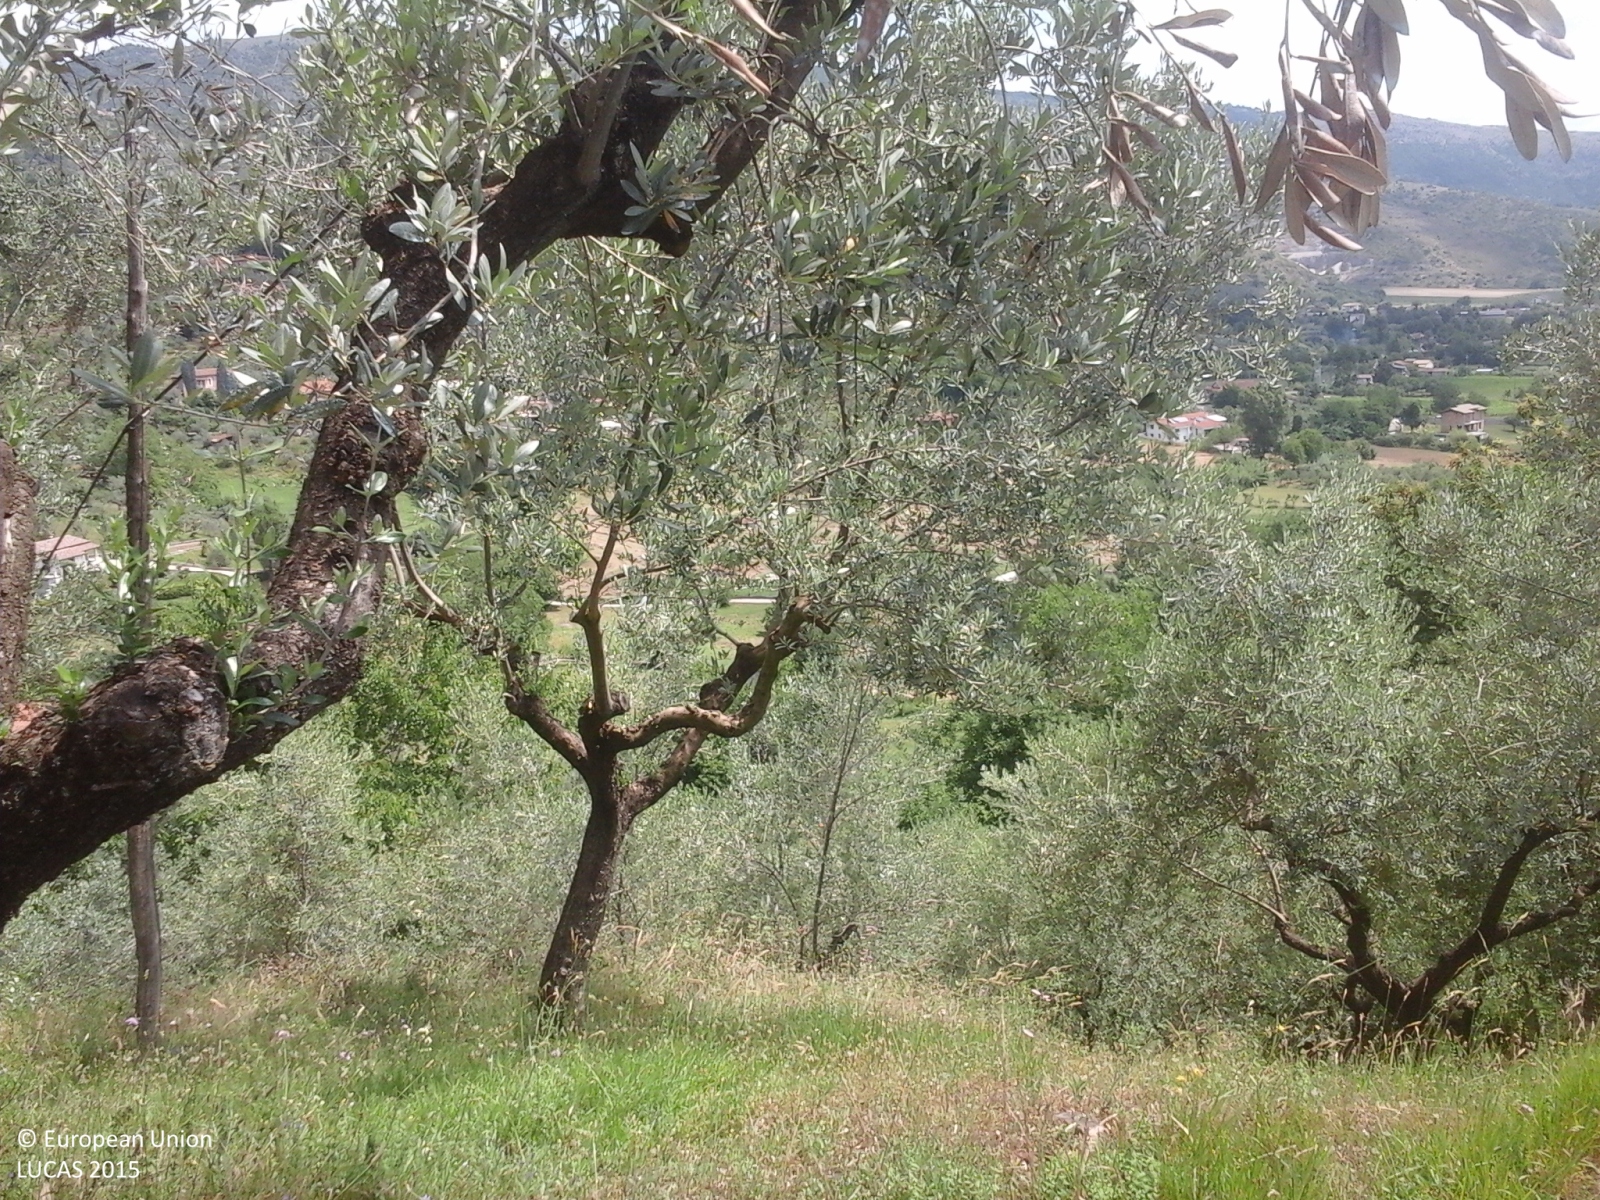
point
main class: Cropland
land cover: Olive groves
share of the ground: 50 - 75 %
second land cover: Grassland without tree/shrub cover
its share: > 75 %
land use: Agriculture (excluding fallow land and kitchen gardens)
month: June
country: IT
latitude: 41.7364
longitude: 13.1743
